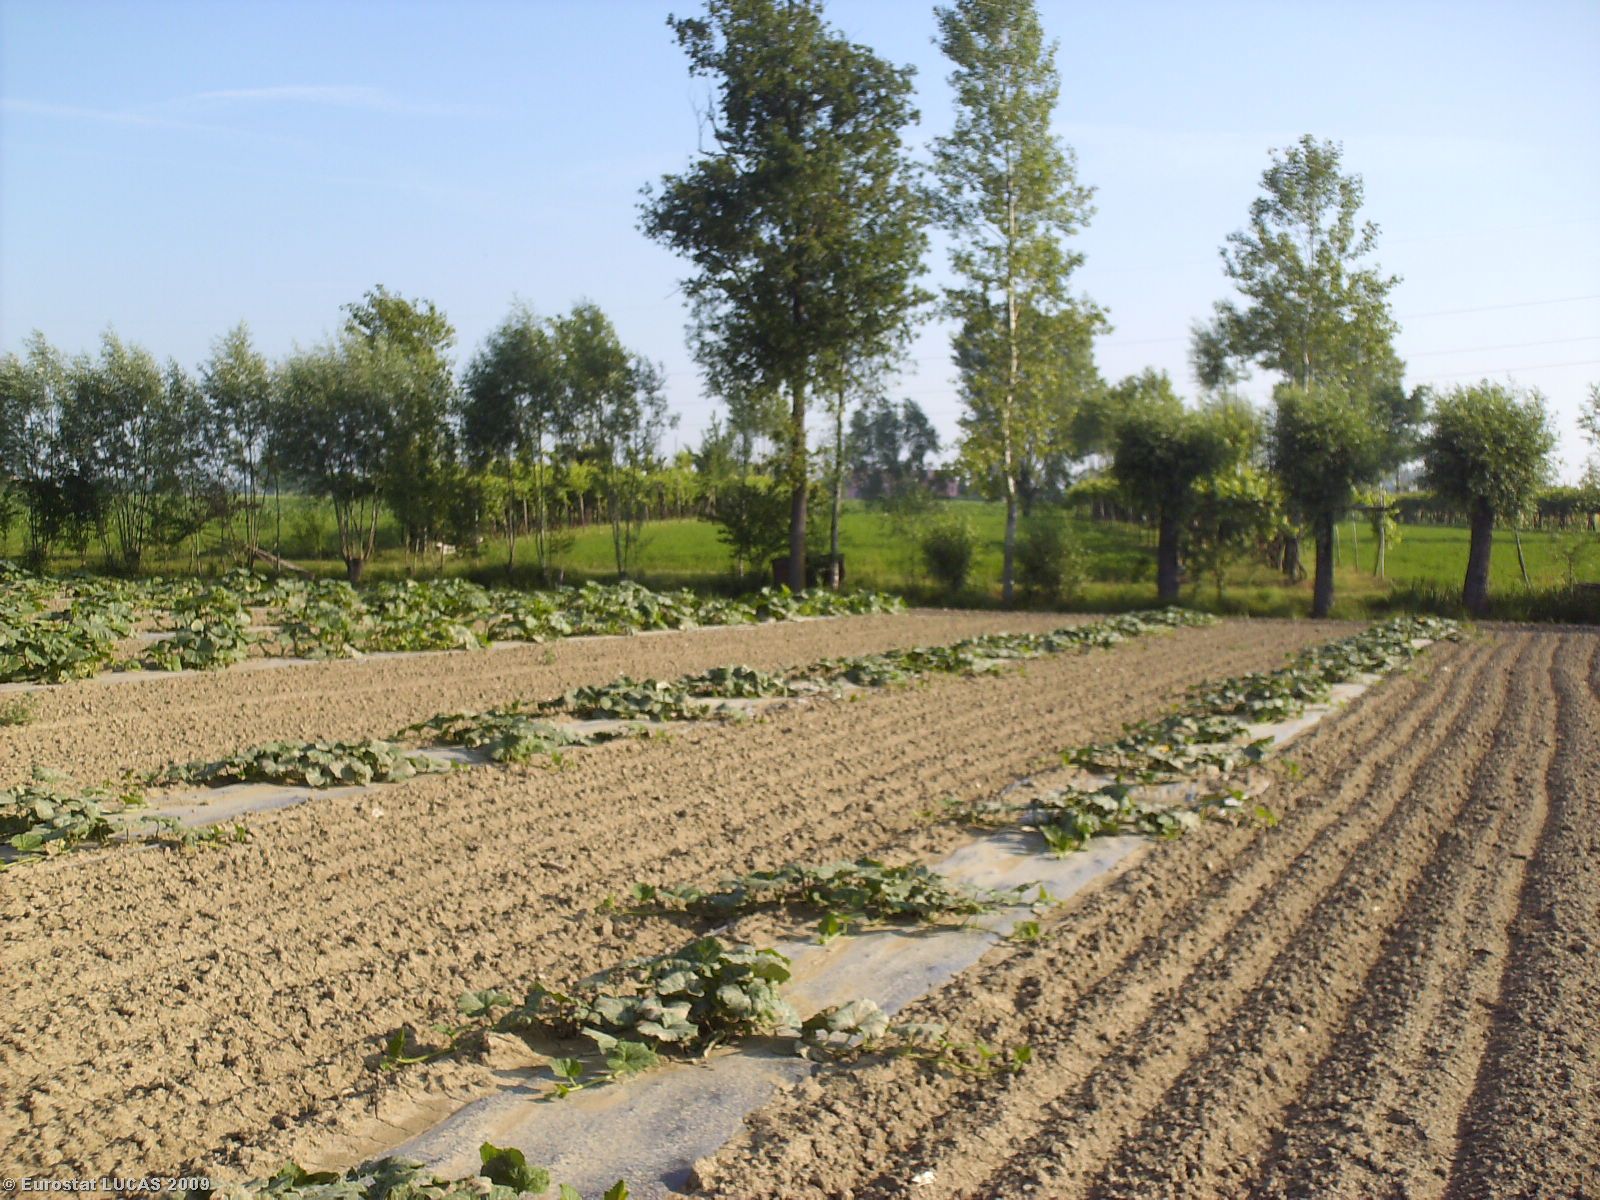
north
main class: Cropland
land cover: Other fresh vegetables
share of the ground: 25 - 50 %
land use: Agriculture (excluding fallow land and kitchen gardens)
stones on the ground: < 10 %
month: June
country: IT
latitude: 44.9441
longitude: 10.5692
